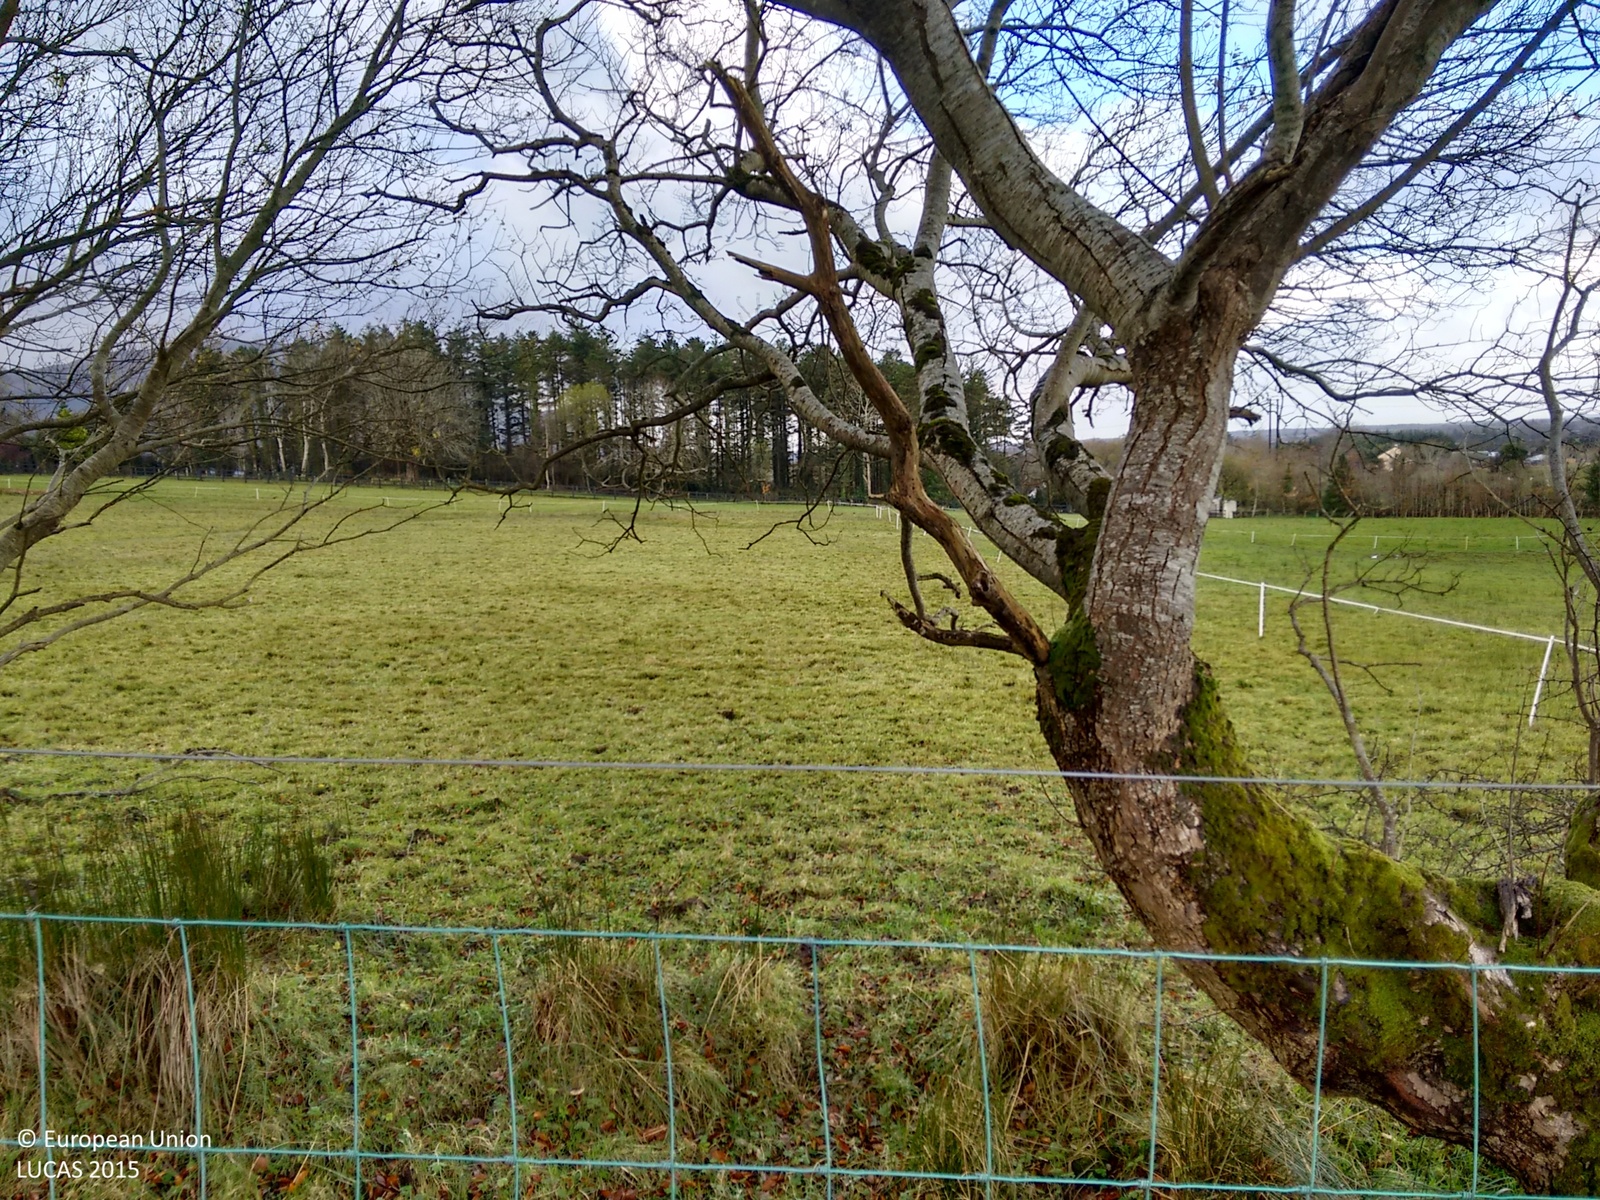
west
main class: Grassland
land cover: Grassland without tree/shrub cover
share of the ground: > 75 %
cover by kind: herbaceous plants 100 %
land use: Agriculture (excluding fallow land and kitchen gardens)
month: November
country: IE
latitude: 54.4289
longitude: -8.2960
